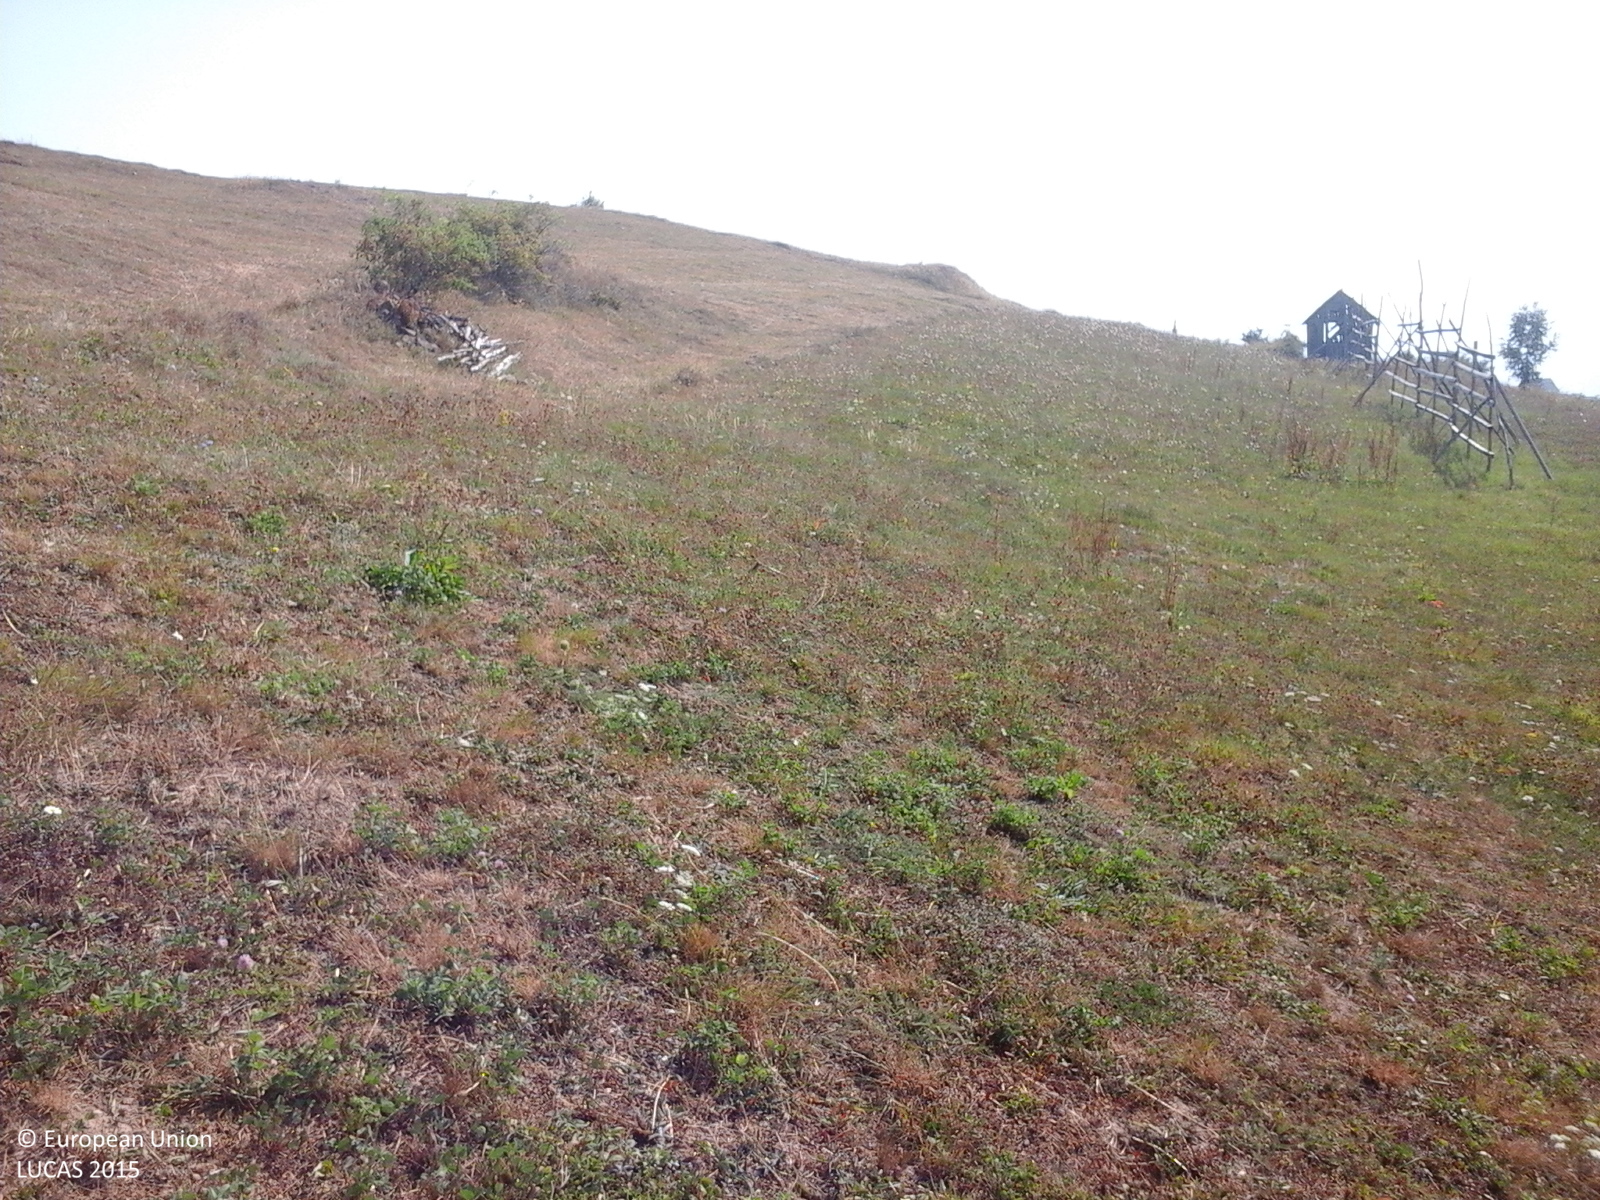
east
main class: Grassland
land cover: Grassland without tree/shrub cover
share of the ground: > 75 %
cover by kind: herbaceous plants 100 %
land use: Agriculture (excluding fallow land and kitchen gardens)
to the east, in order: Grassland without tree/shrub cover
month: September
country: RO
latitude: 47.6761
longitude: 24.5202
